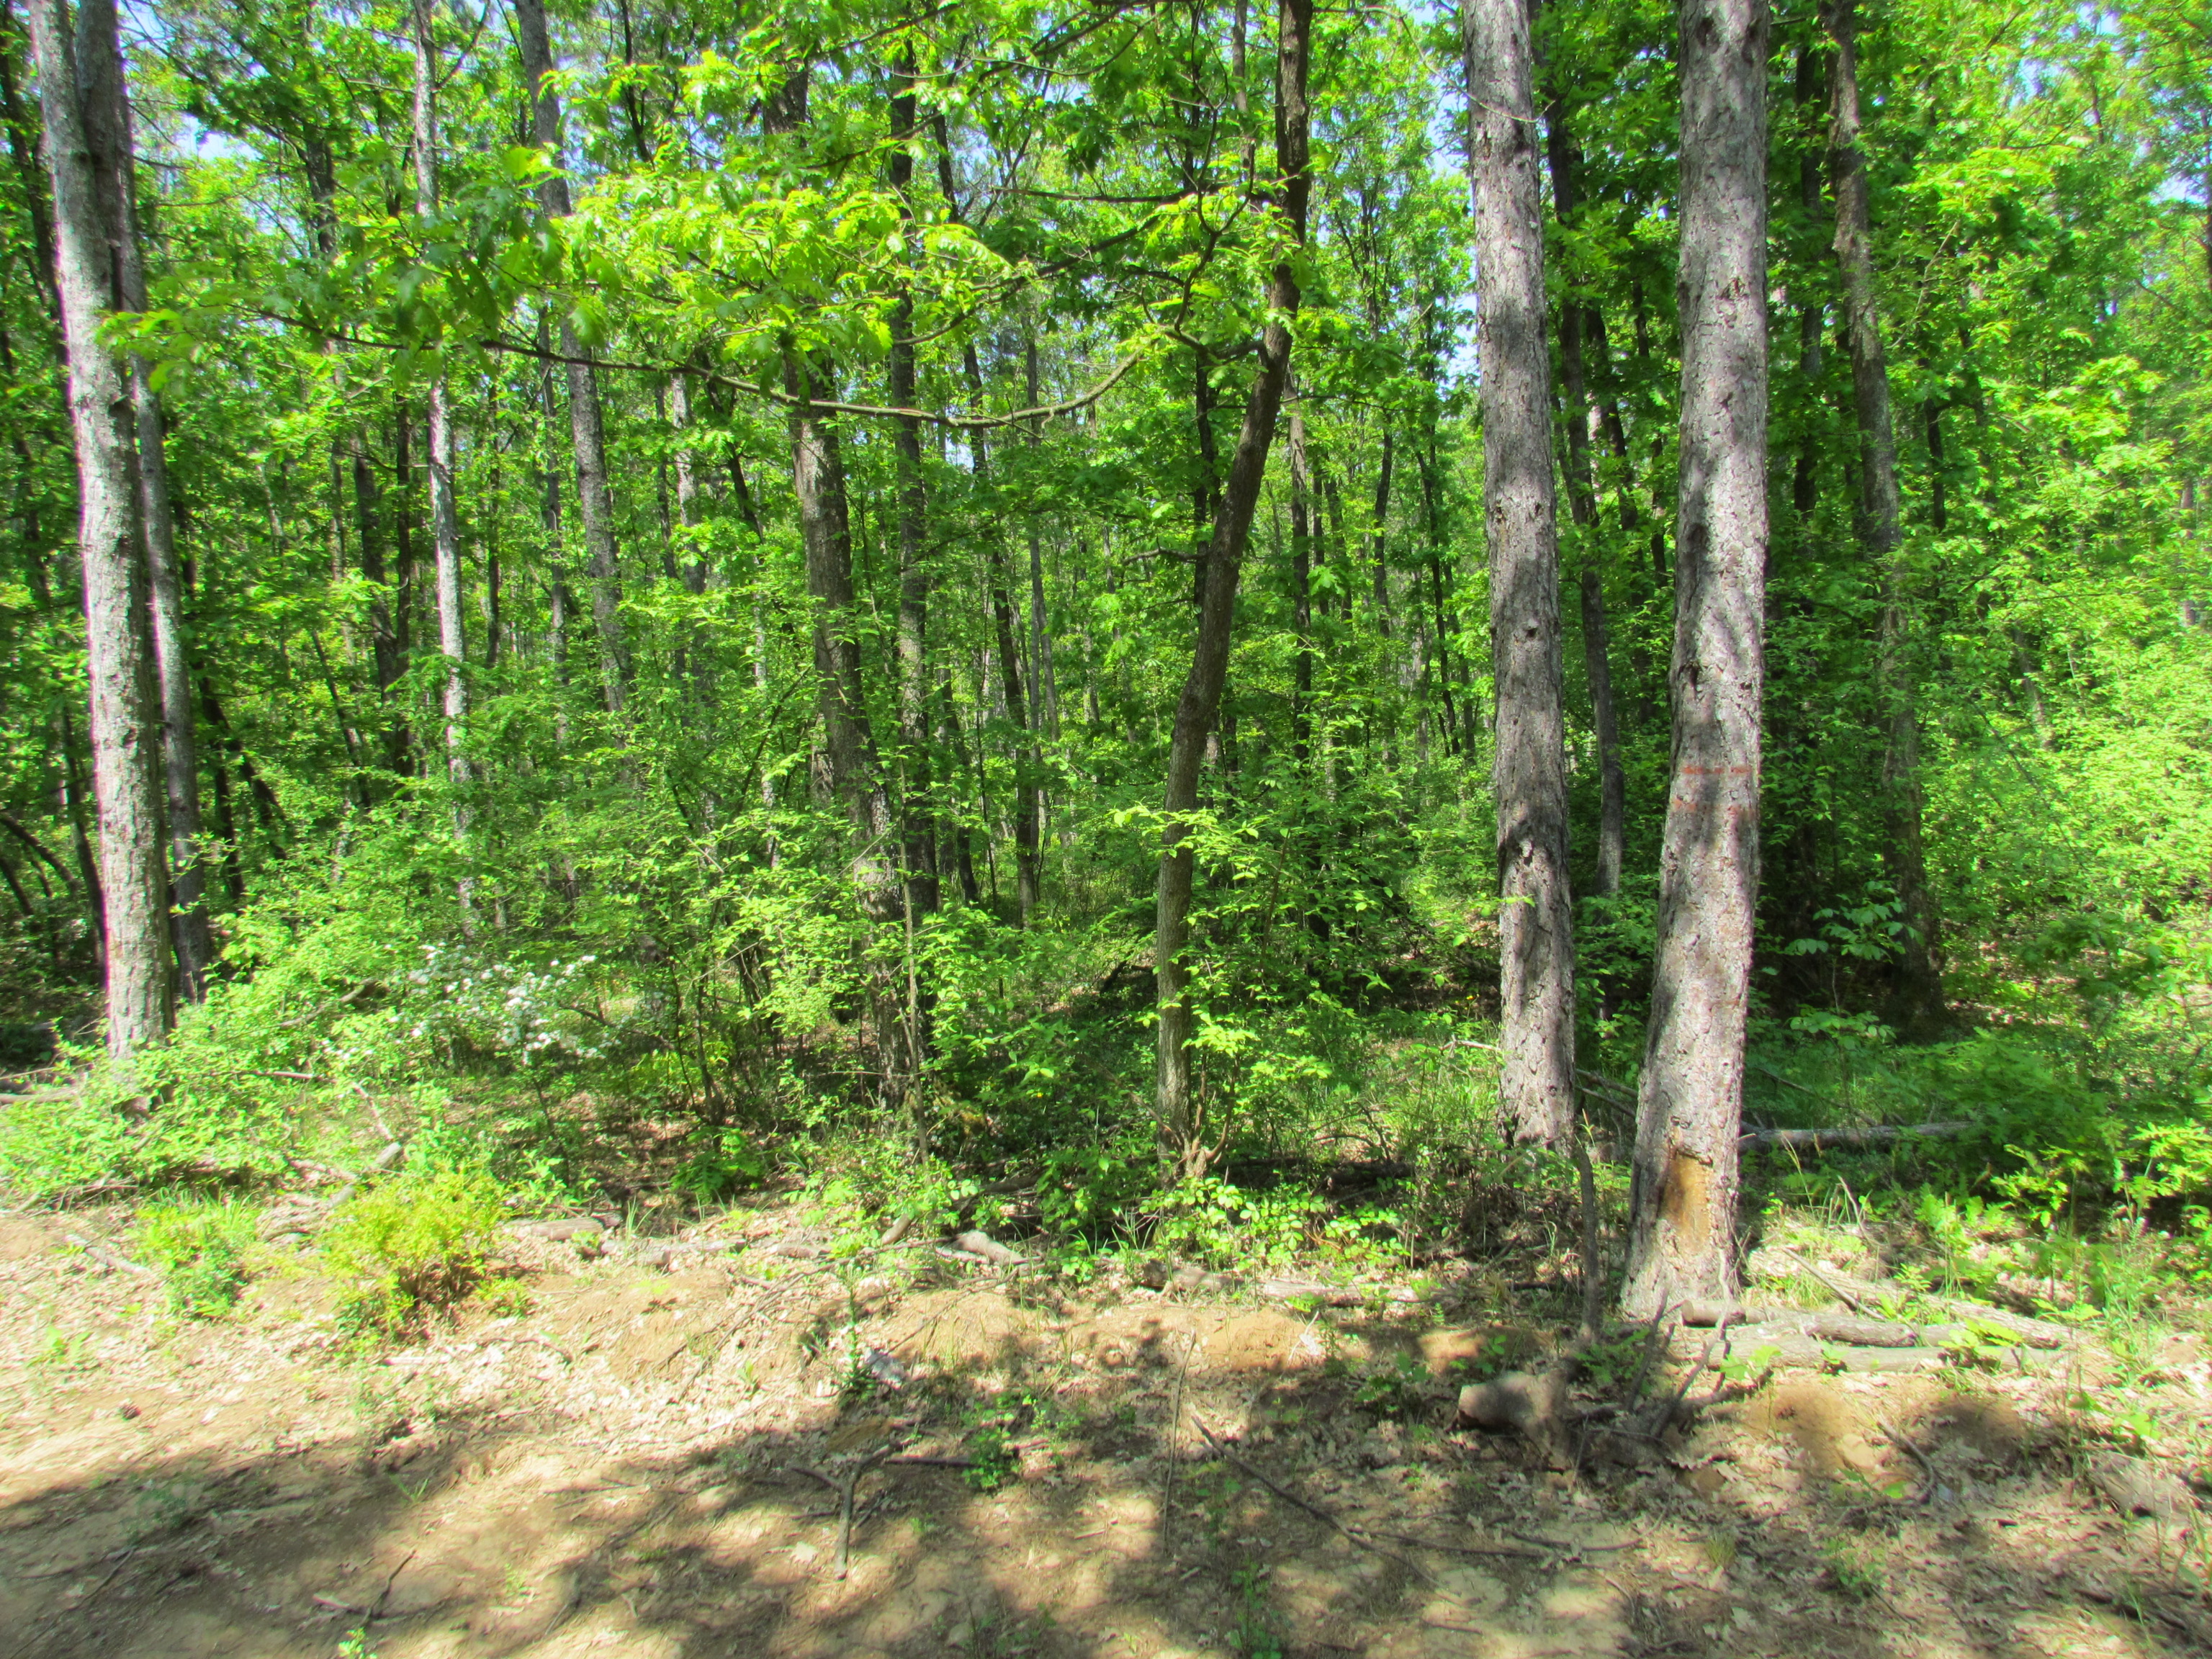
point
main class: Woodland
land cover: Pine dominated mixed woodland
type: hemiboreal forest and nemoral coniferous forest and mixed broadleaved-coniferous forest
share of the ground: > 75 %
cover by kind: broadleaved forest trees 75 %, coniferous forest trees 25 %
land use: Forestry
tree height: > 5 m
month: May
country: BG
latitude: 42.2321
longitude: 27.1286
